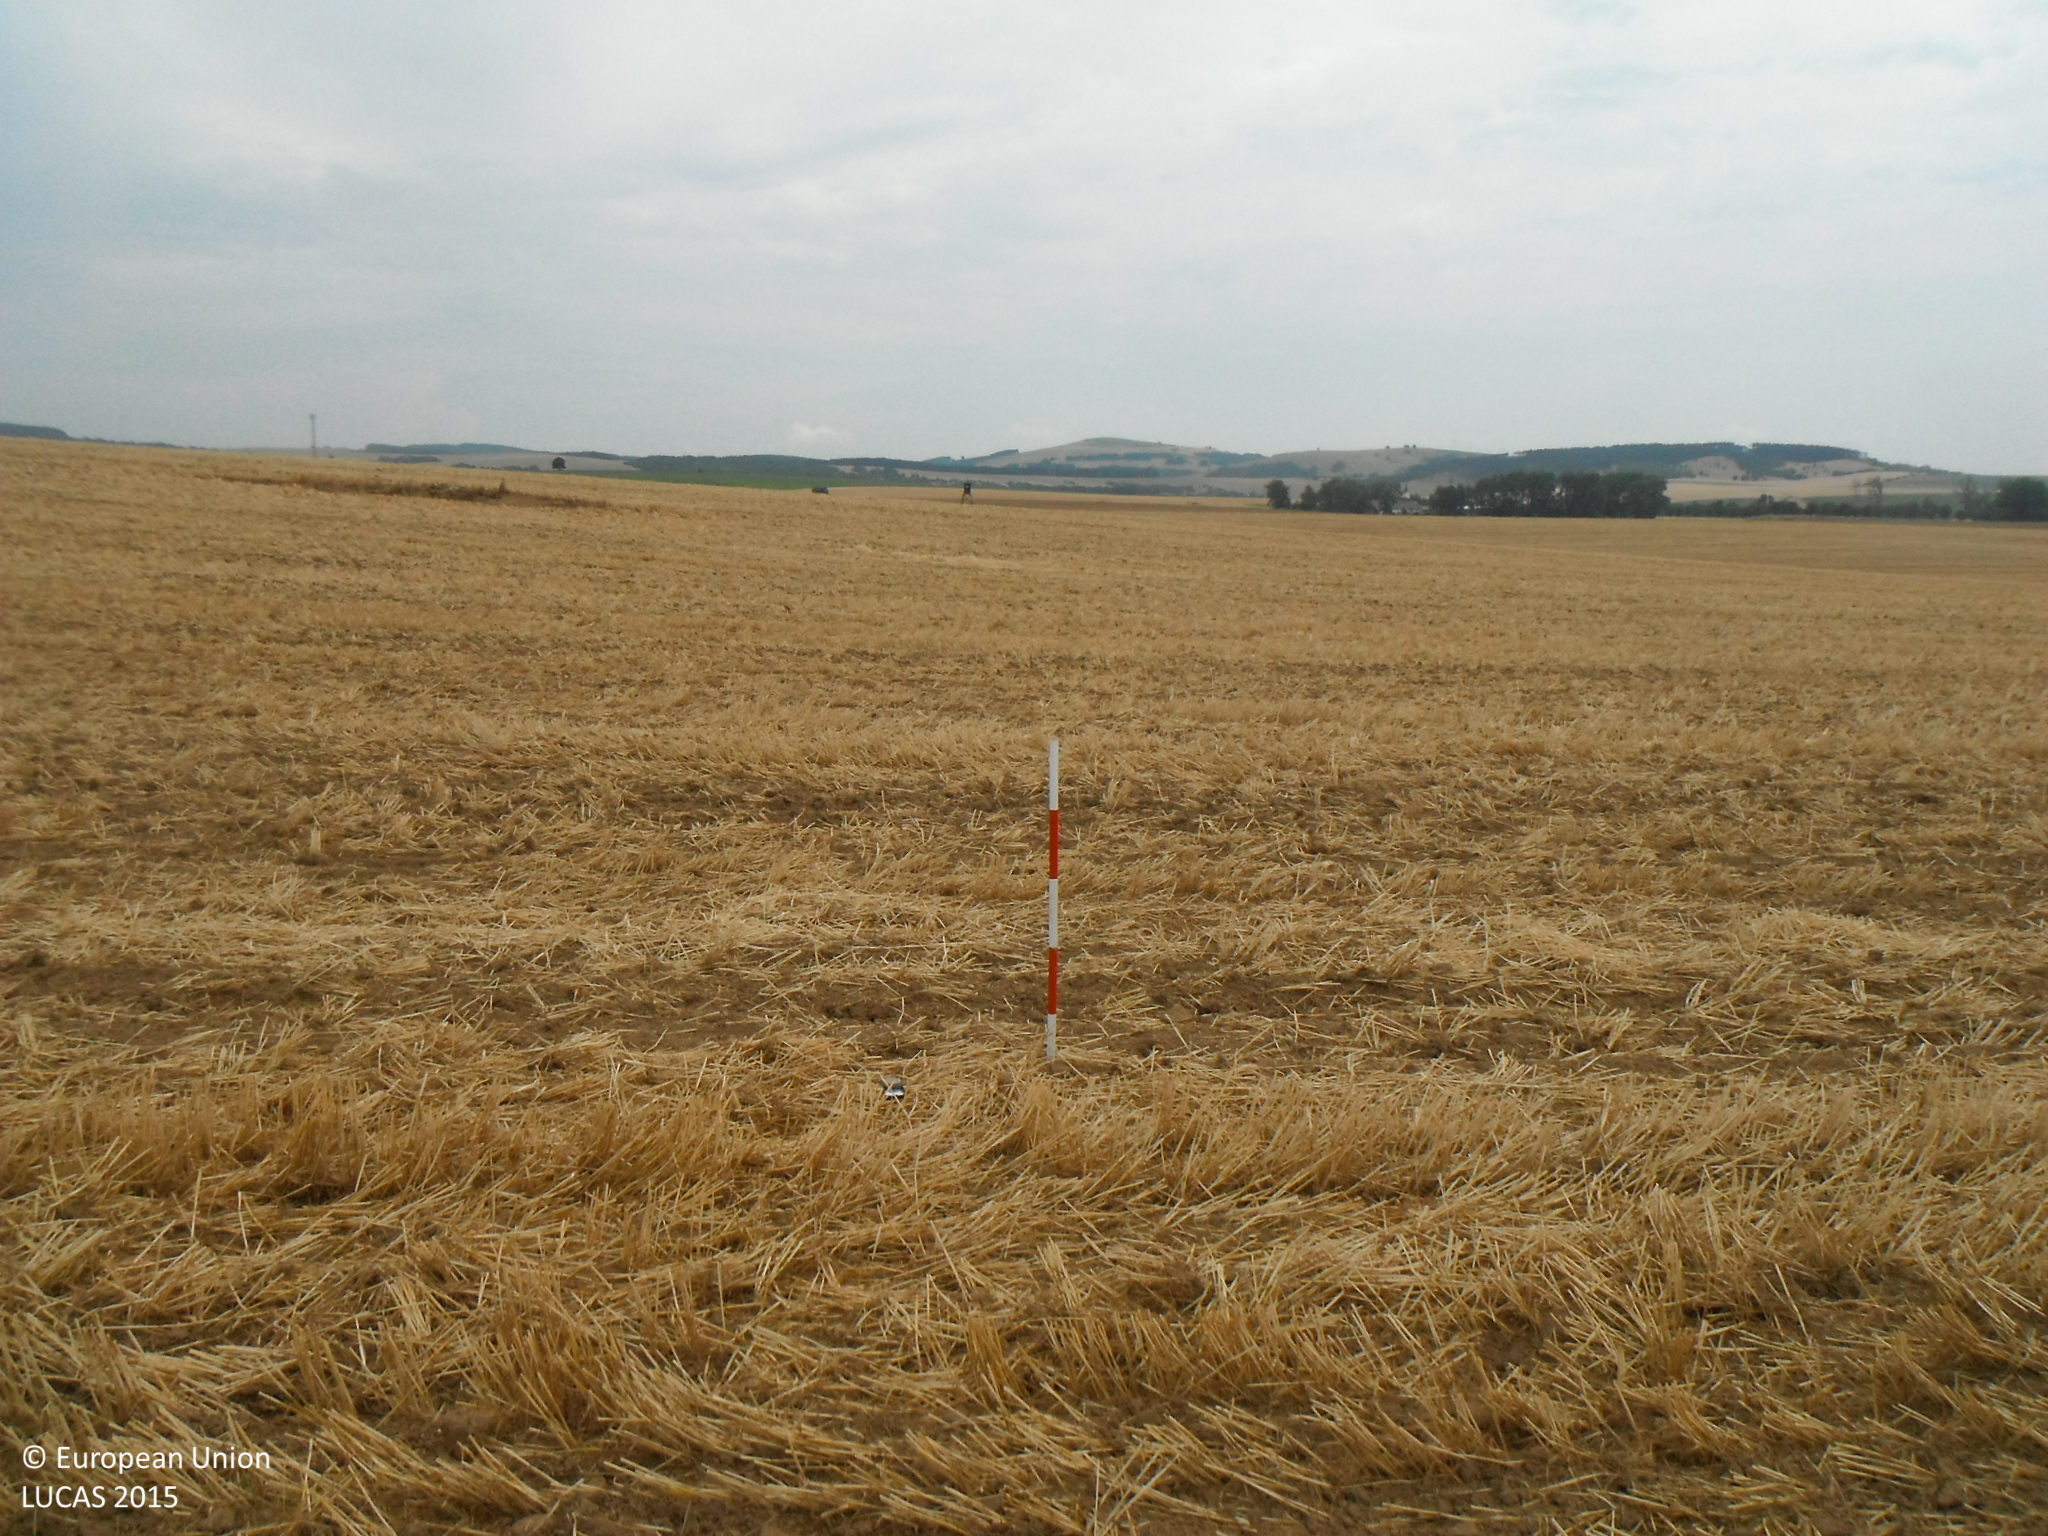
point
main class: Cropland
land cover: Barley
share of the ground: 25 - 50 %
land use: Agriculture (excluding fallow land and kitchen gardens)
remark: Harvested field
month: July
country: SK
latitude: 48.7769
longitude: 17.2903
